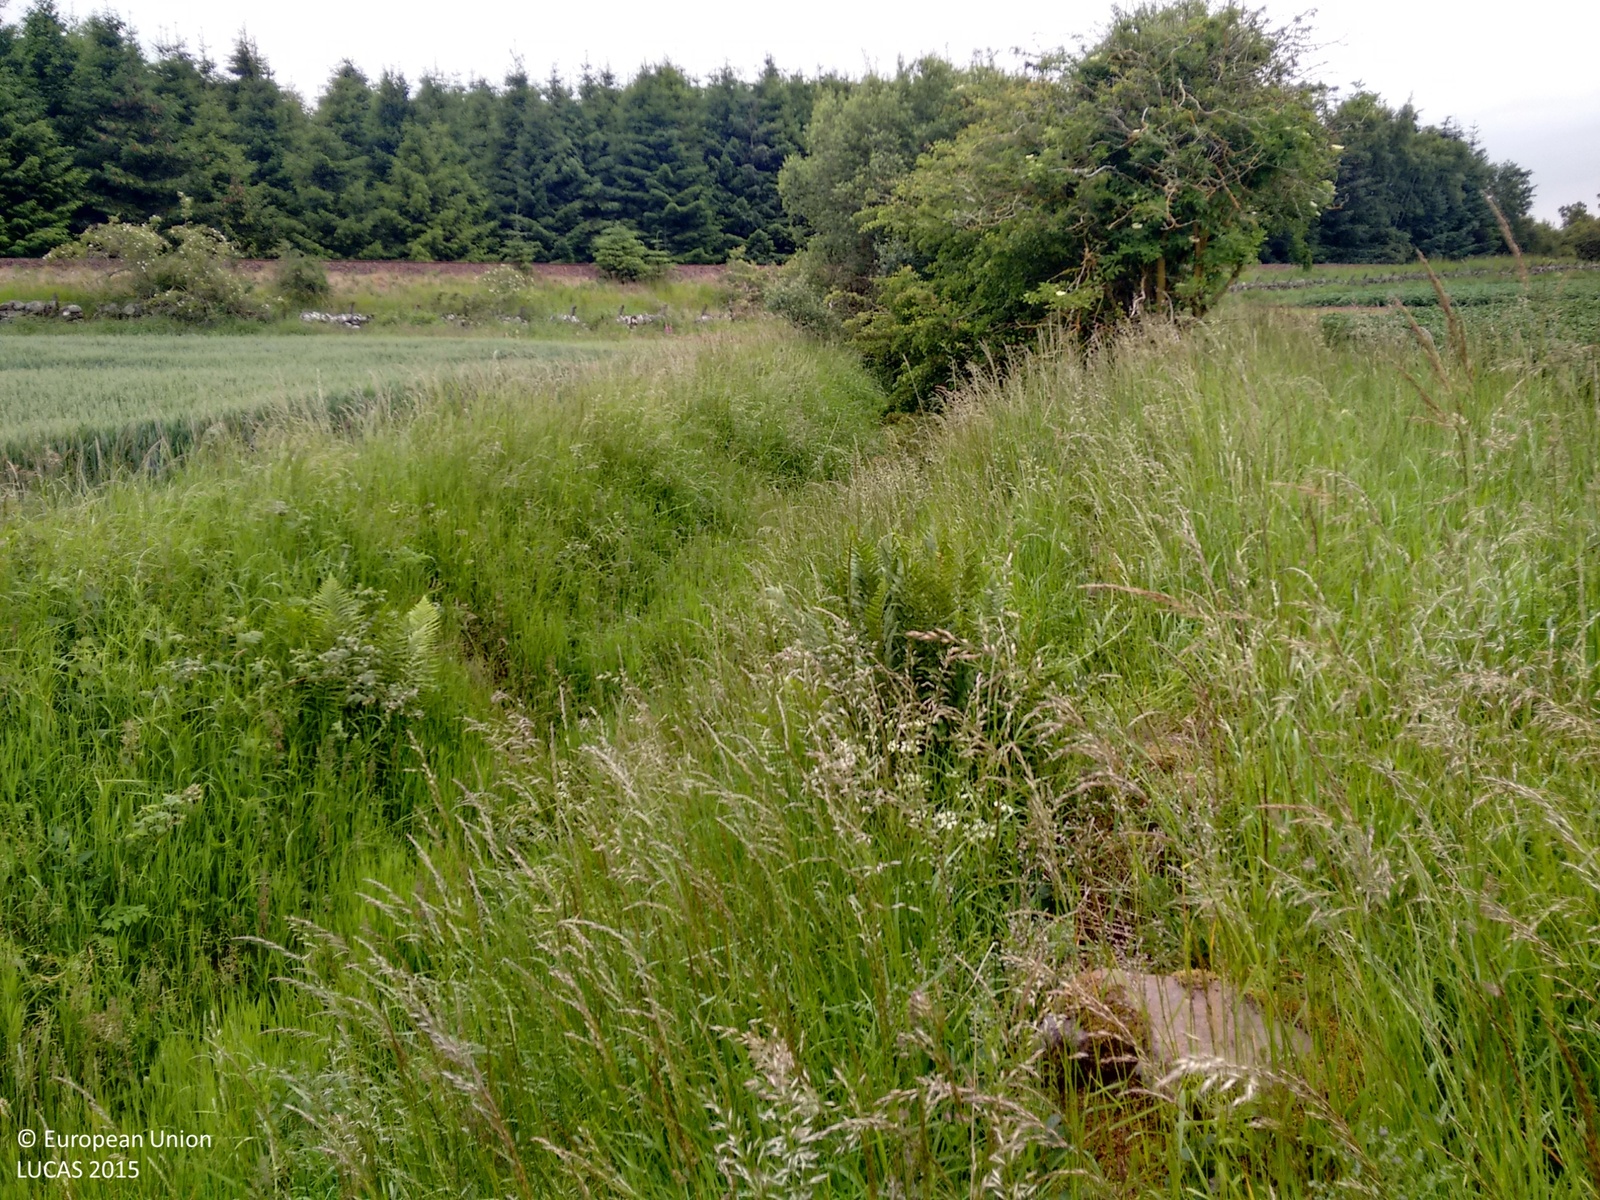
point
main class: Cropland
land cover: Potatoes
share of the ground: > 75 %
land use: Agriculture (excluding fallow land and kitchen gardens)
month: June
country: GB
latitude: 56.4986
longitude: -3.4434
